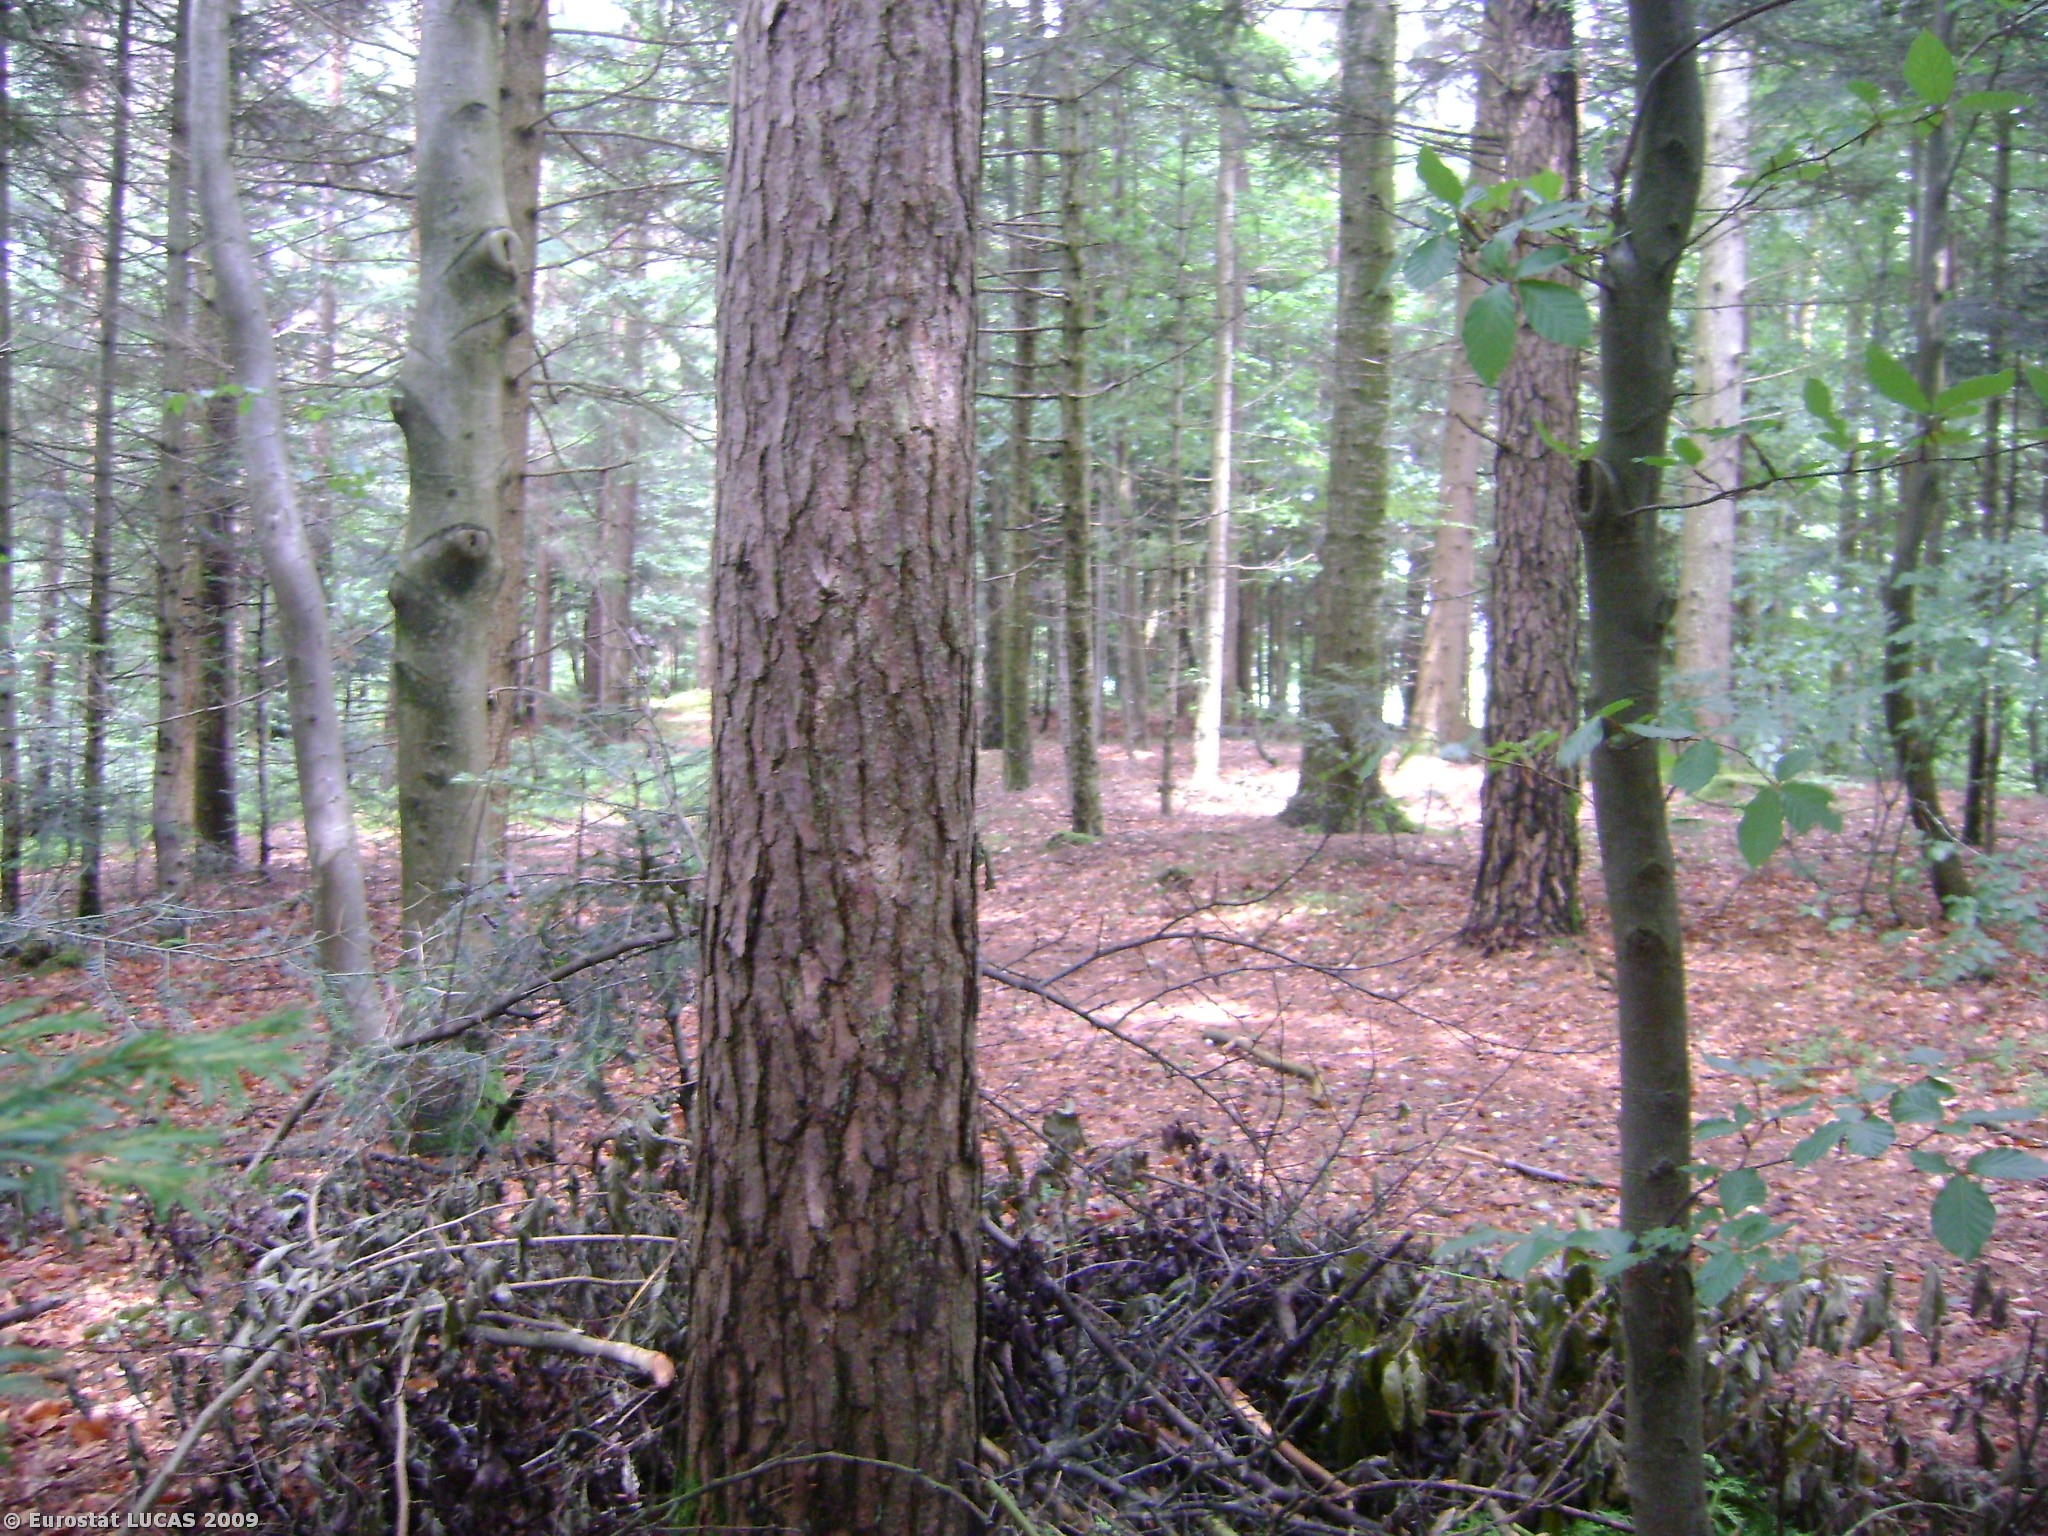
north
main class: Woodland
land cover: Mixed woodland
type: hemiboreal forest and nemoral coniferous forest and mixed broadleaved-coniferous forest
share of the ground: > 75 %
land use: Forestry
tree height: > 5 m
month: June
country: AT
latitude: 48.1392
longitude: 13.2647
